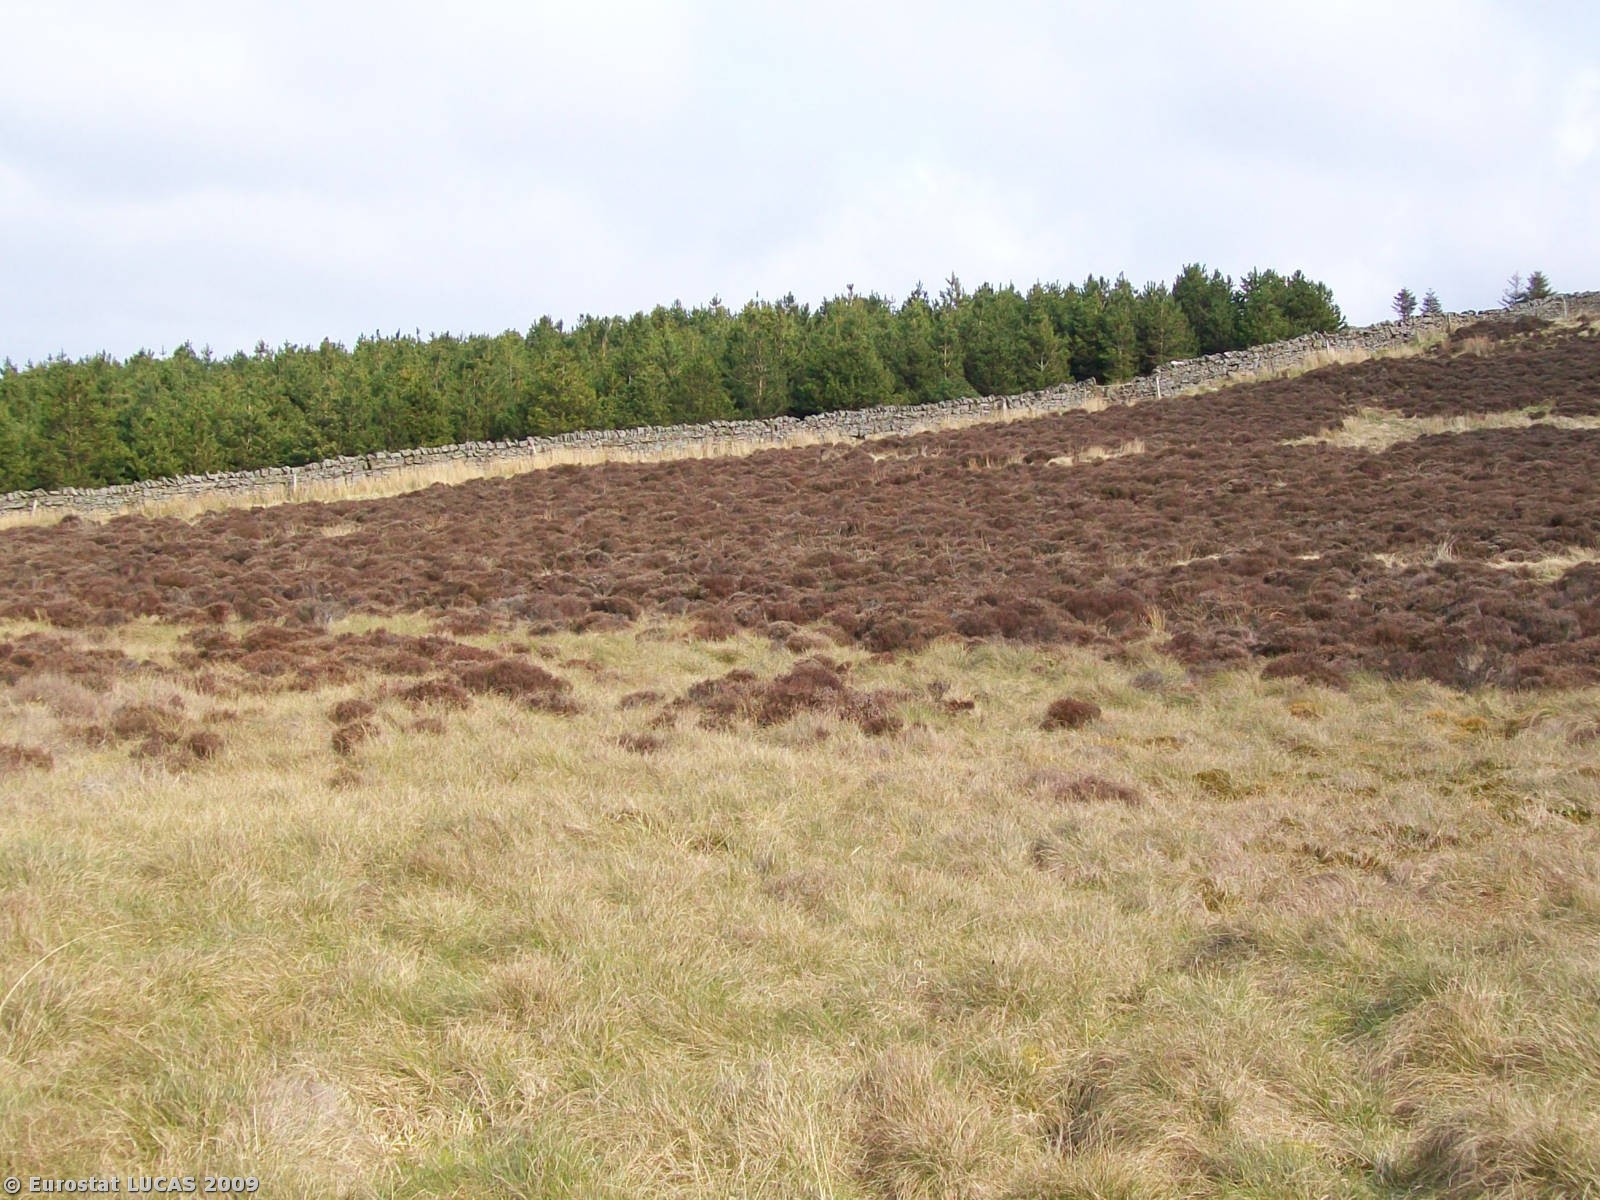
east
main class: Shrubland
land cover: Shrubland without tree cover
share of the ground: > 75 %
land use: Agriculture (excluding fallow land and kitchen gardens)
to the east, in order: Shrubland without tree cover; Fences; Dry stone walls; Coniferous woodland
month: April
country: GB
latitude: 55.1552
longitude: -2.1245
